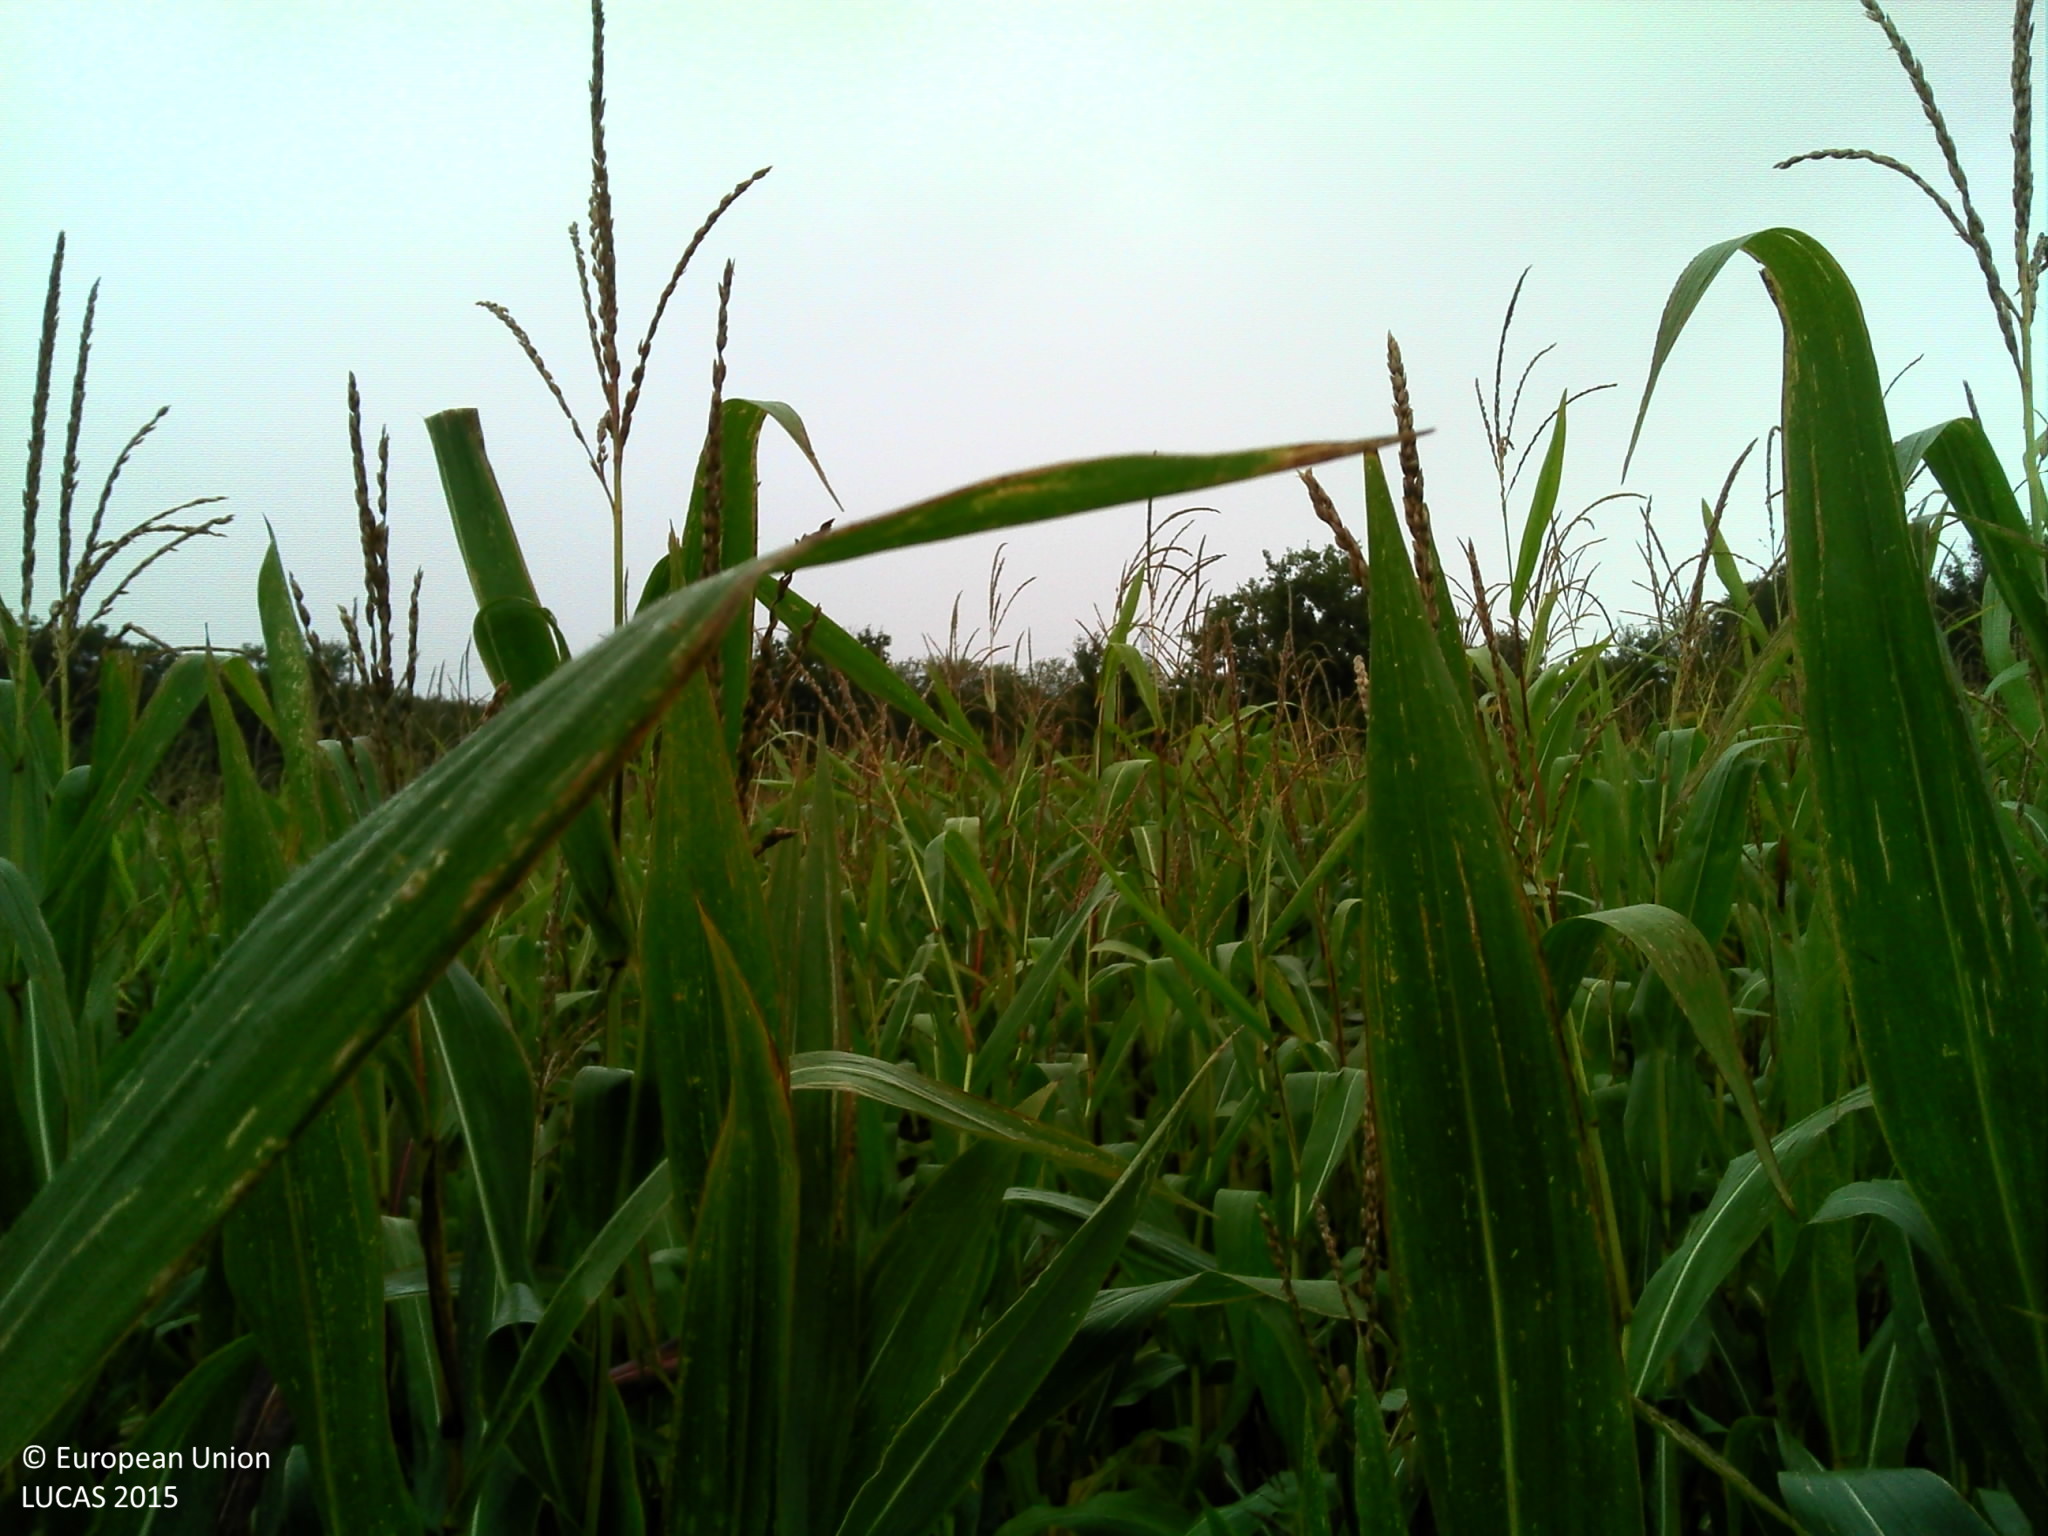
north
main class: Cropland
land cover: Maize
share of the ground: > 75 %
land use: Agriculture (excluding fallow land and kitchen gardens)
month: September
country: FR
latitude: 46.6317
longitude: -1.3878
